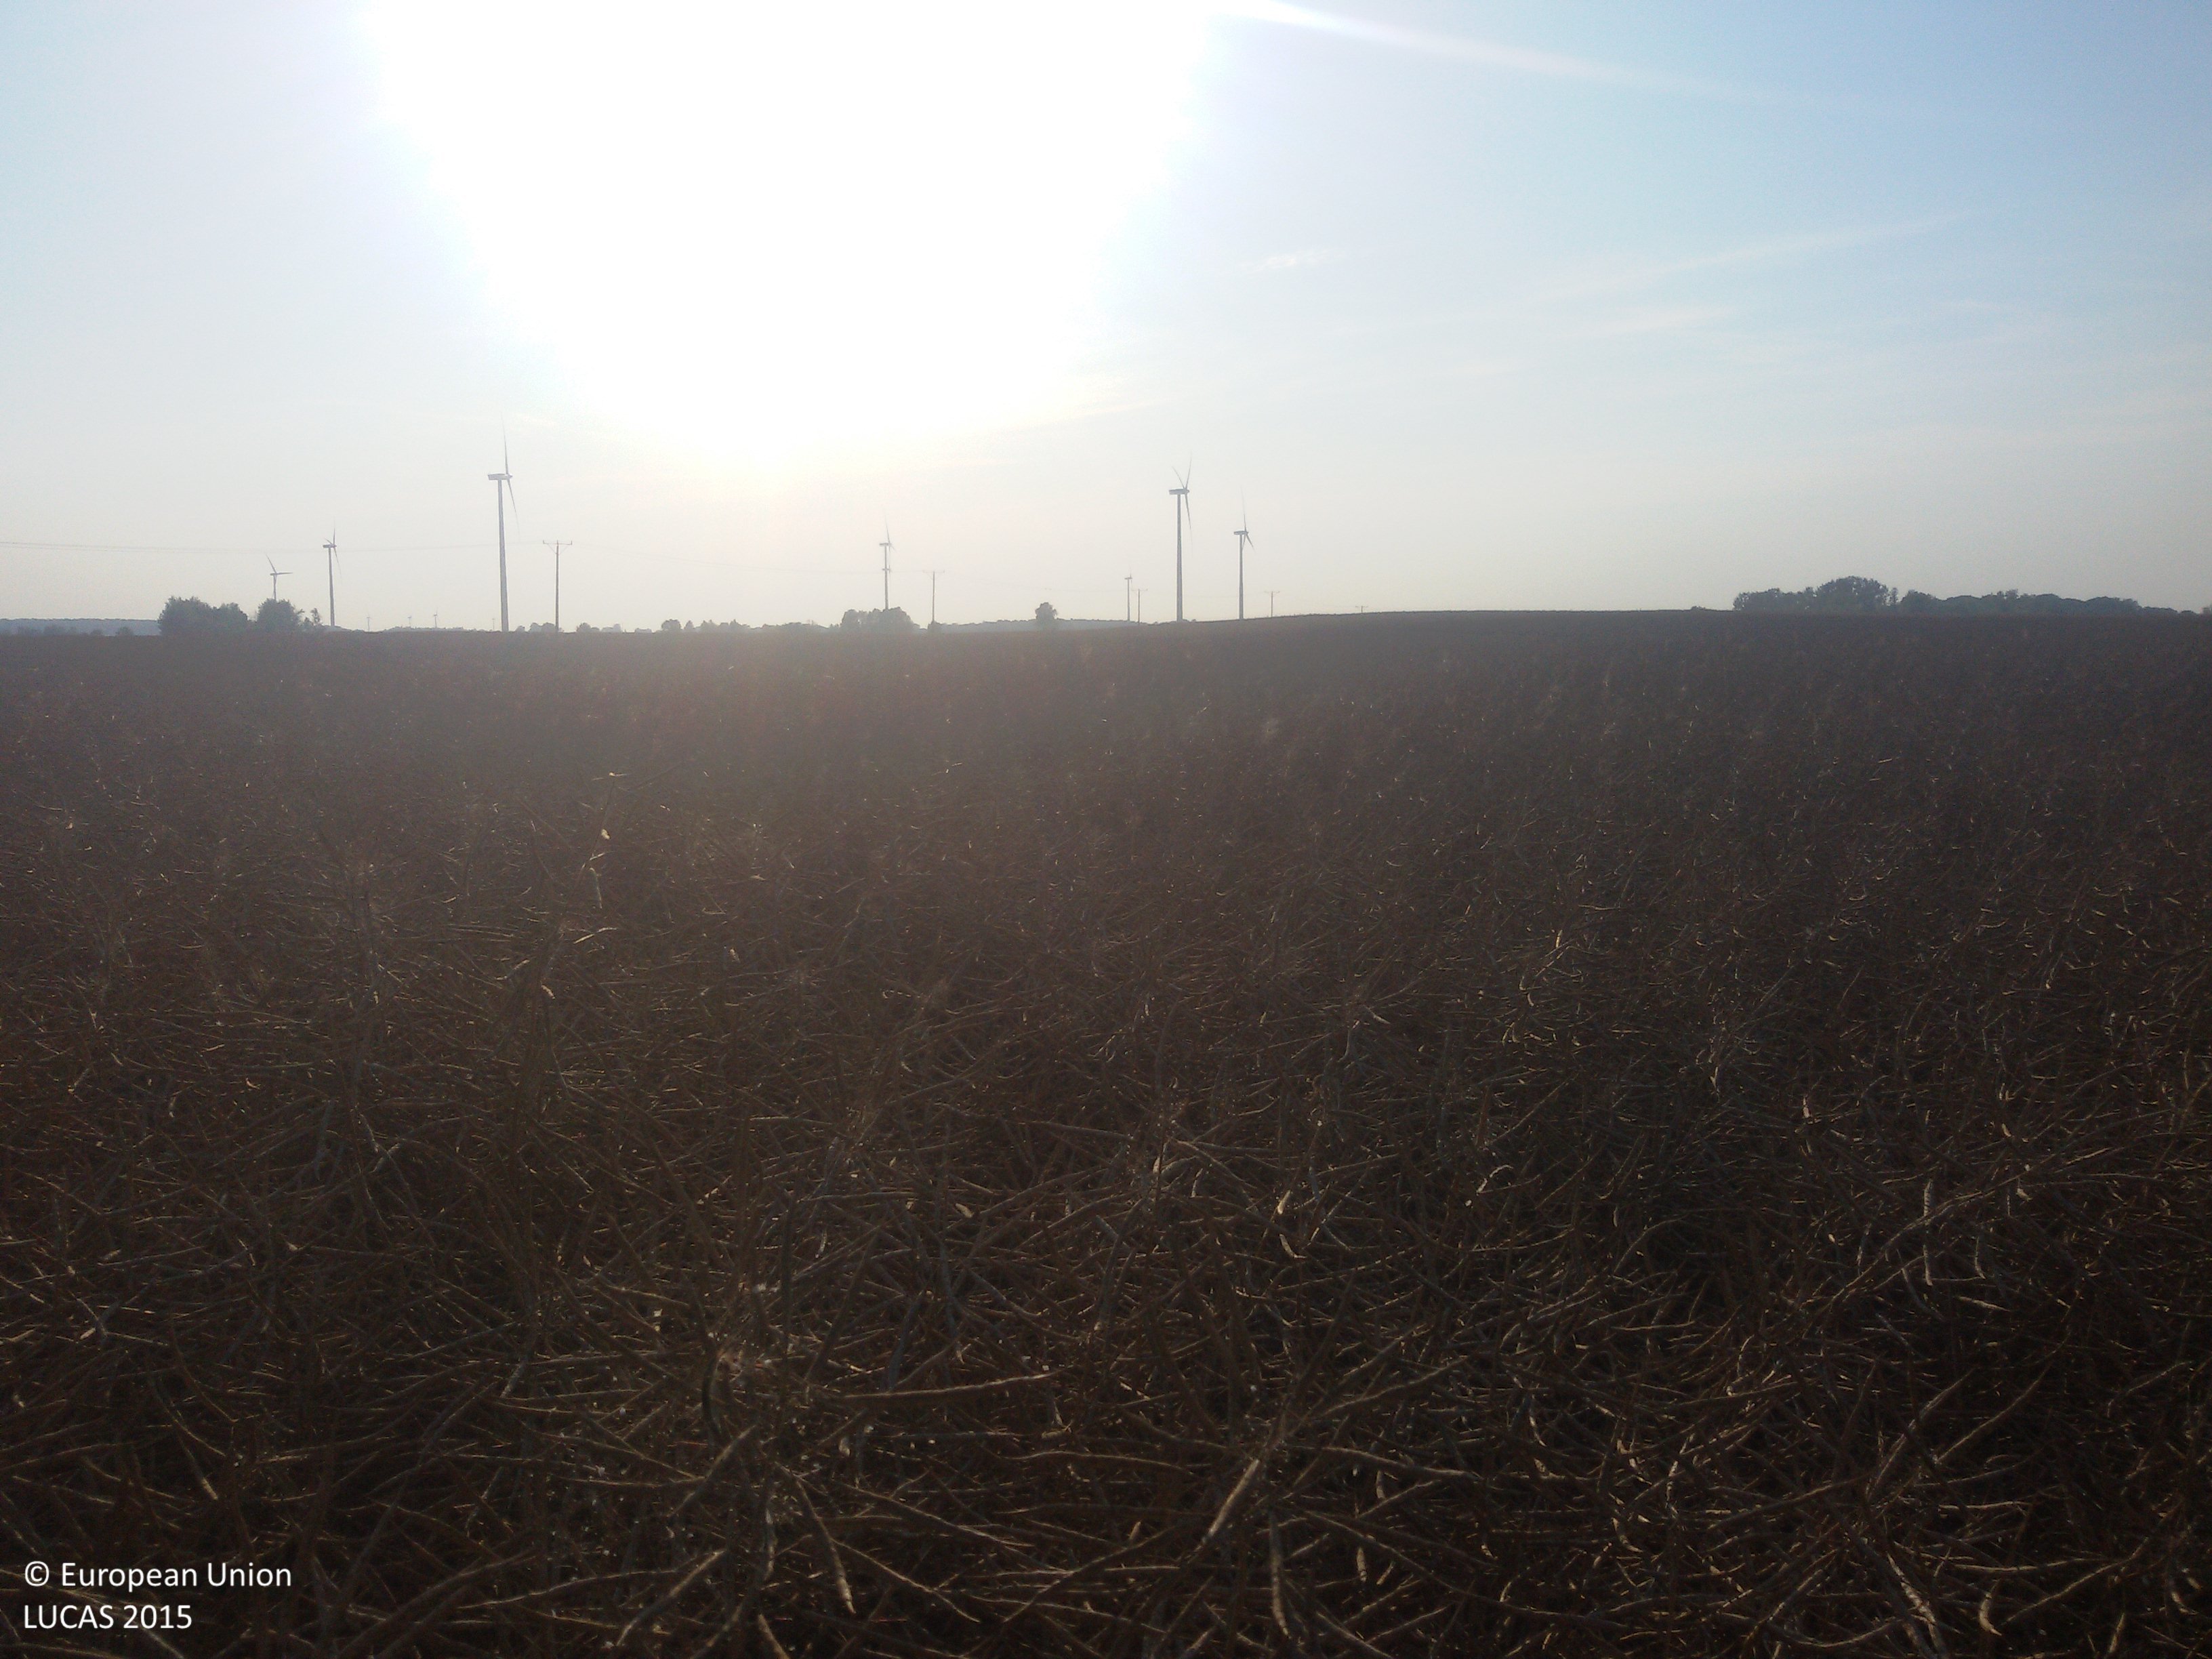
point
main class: Cropland
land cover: Rape and turnip rape
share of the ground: > 75 %
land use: Agriculture (excluding fallow land and kitchen gardens)
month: August
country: PL
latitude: 54.1511
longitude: 21.2069
